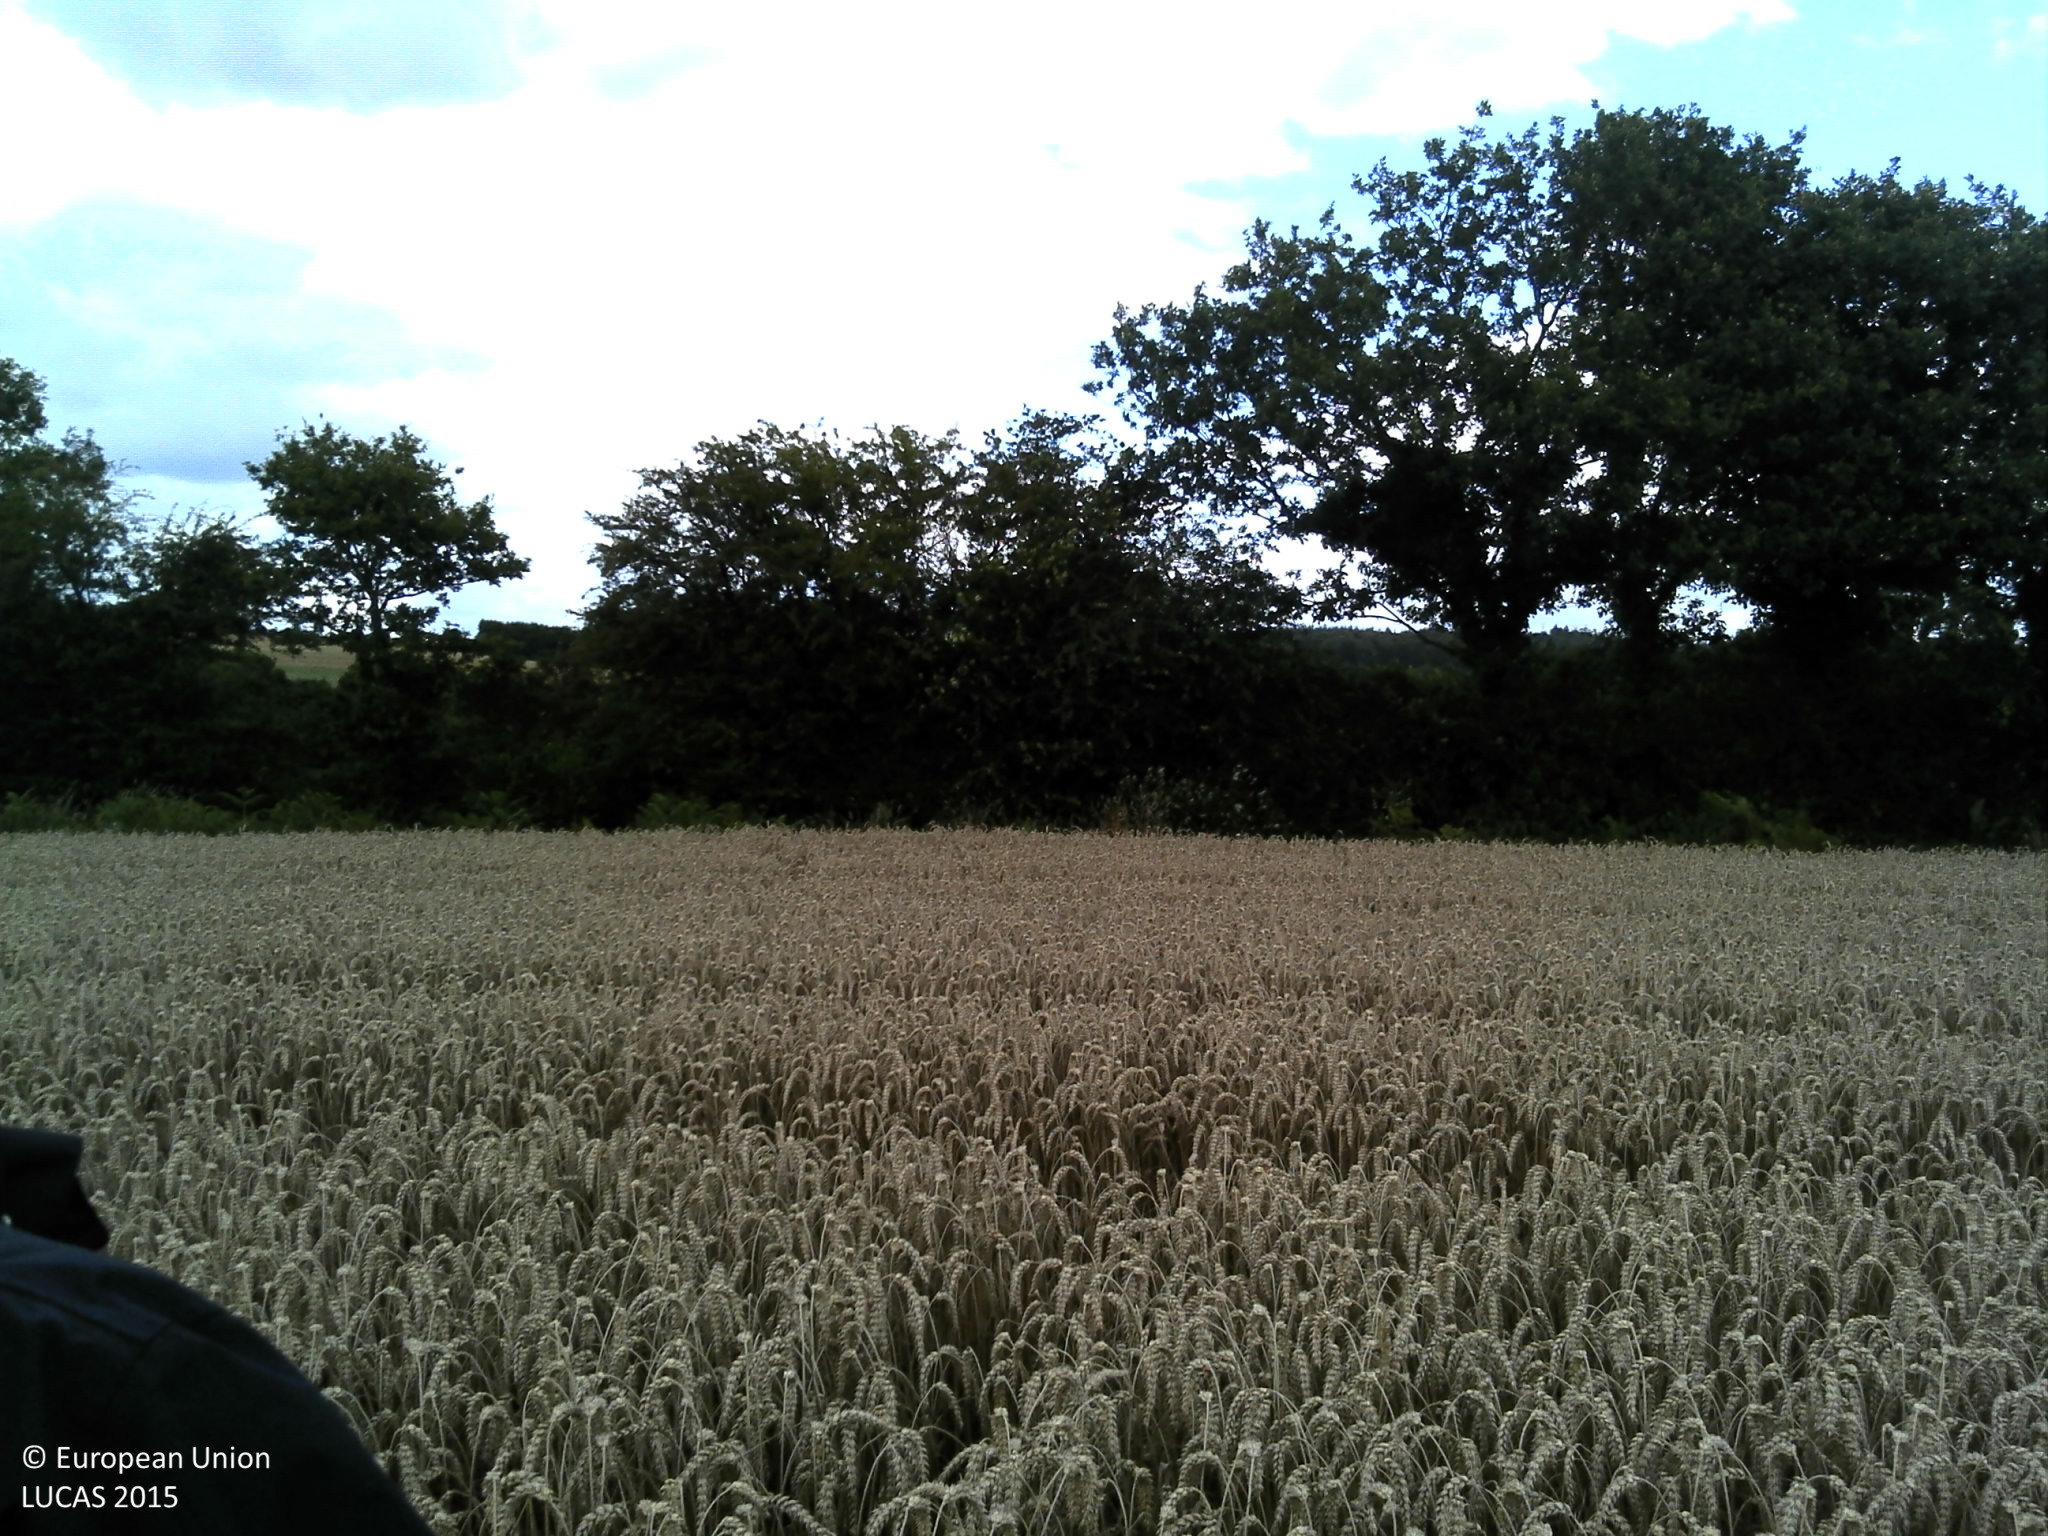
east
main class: Cropland
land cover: Common wheat
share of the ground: > 75 %
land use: Agriculture (excluding fallow land and kitchen gardens)
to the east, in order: Common wheat; Ditches and canals; Tracks; Grass margins; Lines of trees; Common wheat; Lines of trees; Fences; Grassland without tree/shrub cover; Fences; Grassland without tree/shrub cover; Fences; Grassland without tree/shrub cover
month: July
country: FR
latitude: 48.2994
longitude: -3.6560
